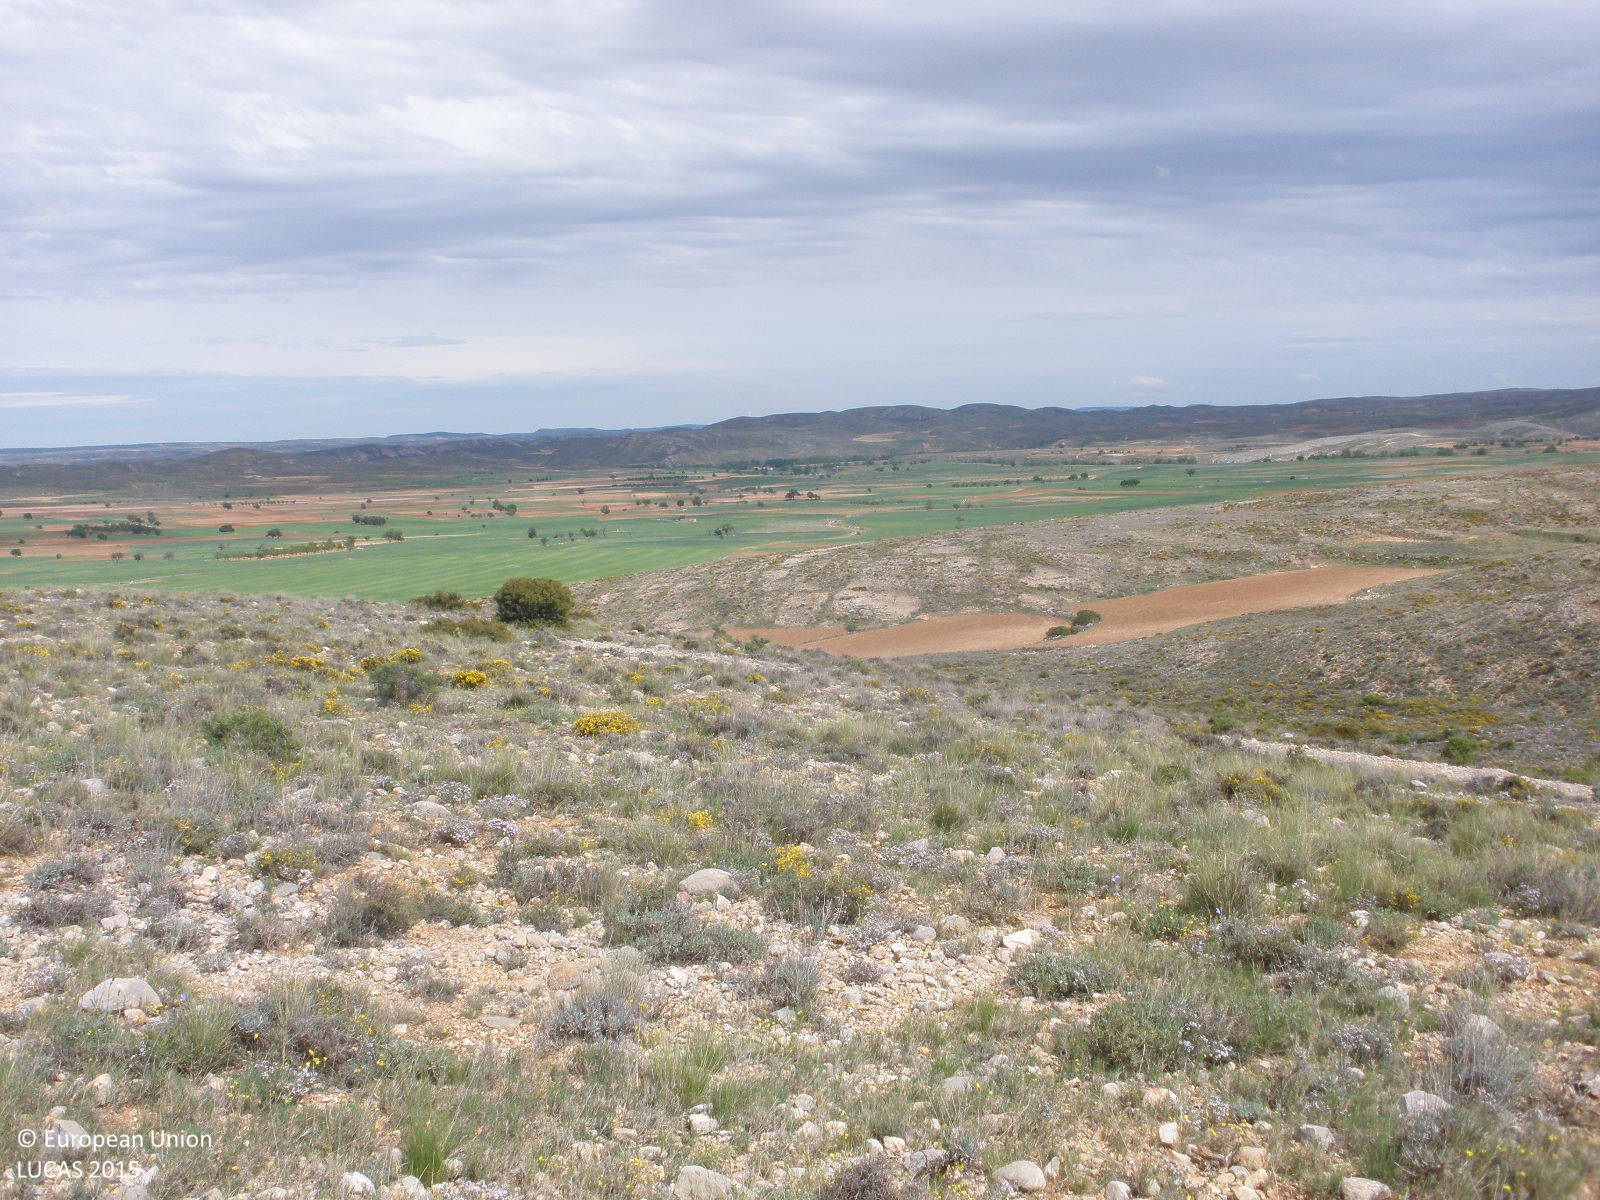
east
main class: Shrubland
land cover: Shrubland without tree cover
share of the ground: 25 - 50 %
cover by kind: shrubs 40 %, herbaceous plants 30 %, consolidated bare surface 30 %
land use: Semi-natural and natural areas not in use
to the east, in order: Shrubland without tree cover; Other bare soil
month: May
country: ES
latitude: 41.0386
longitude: -0.9484
